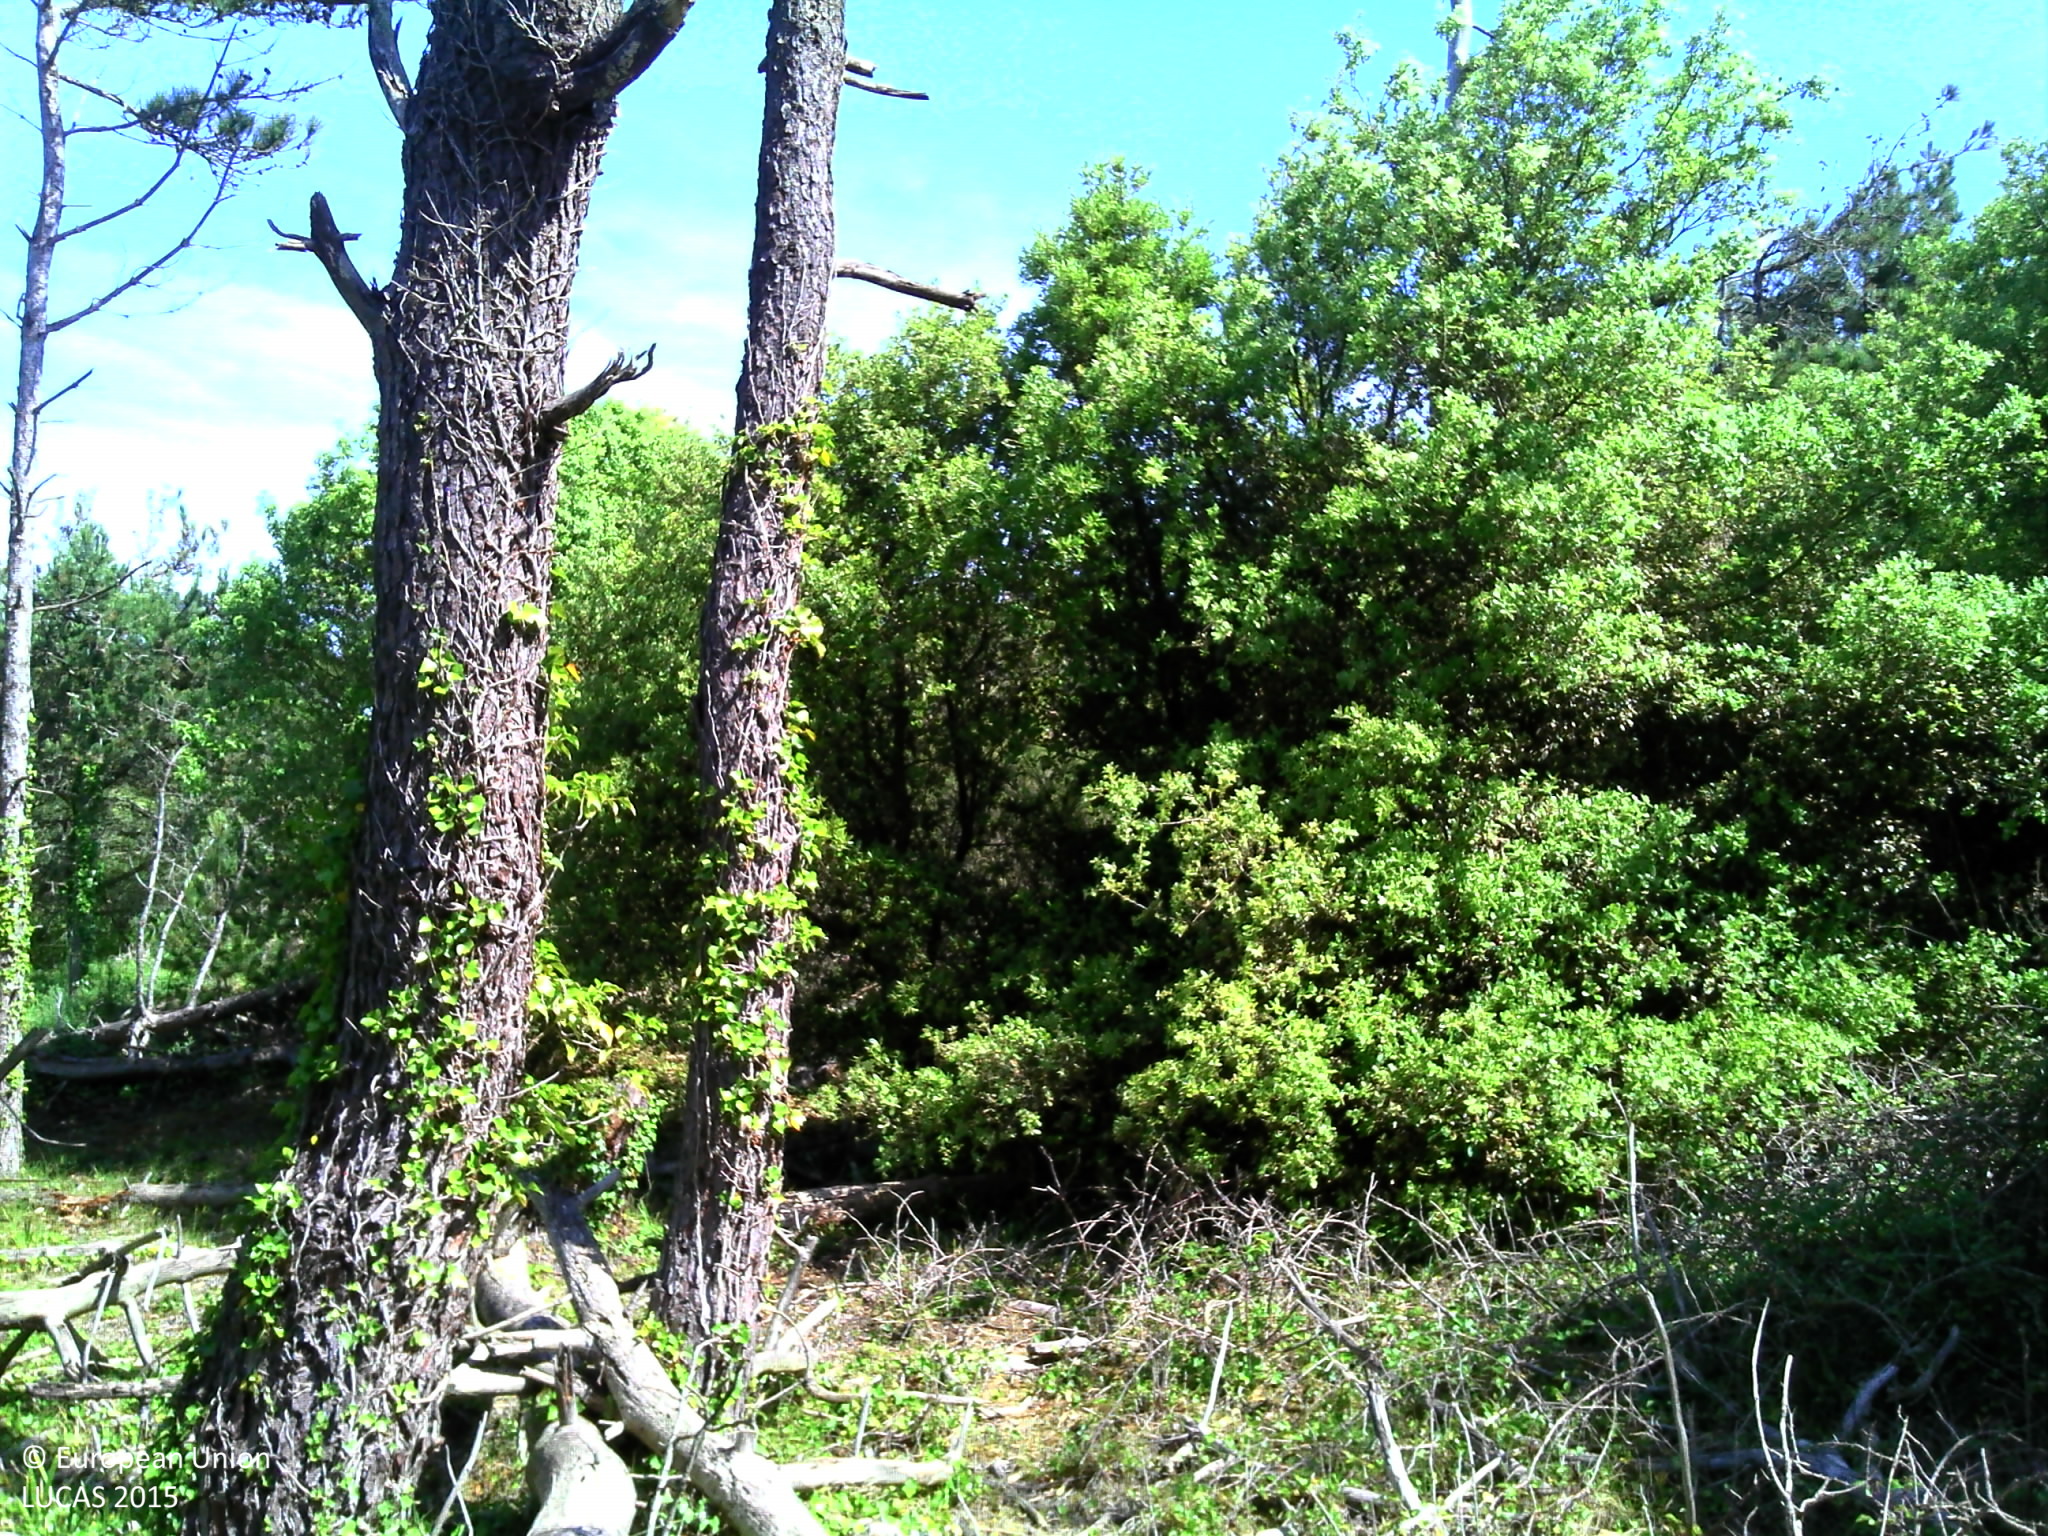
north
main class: Woodland
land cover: Pine dominated mixed woodland
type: coniferous forest of the mediterranean region
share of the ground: > 75 %
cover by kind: coniferous forest trees 75 %, broadleaved forest trees 25 %
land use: Forestry
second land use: Agriculture (excluding fallow land and kitchen gardens)
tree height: > 5 m
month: May
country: FR
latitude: 46.2542
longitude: -1.5169
